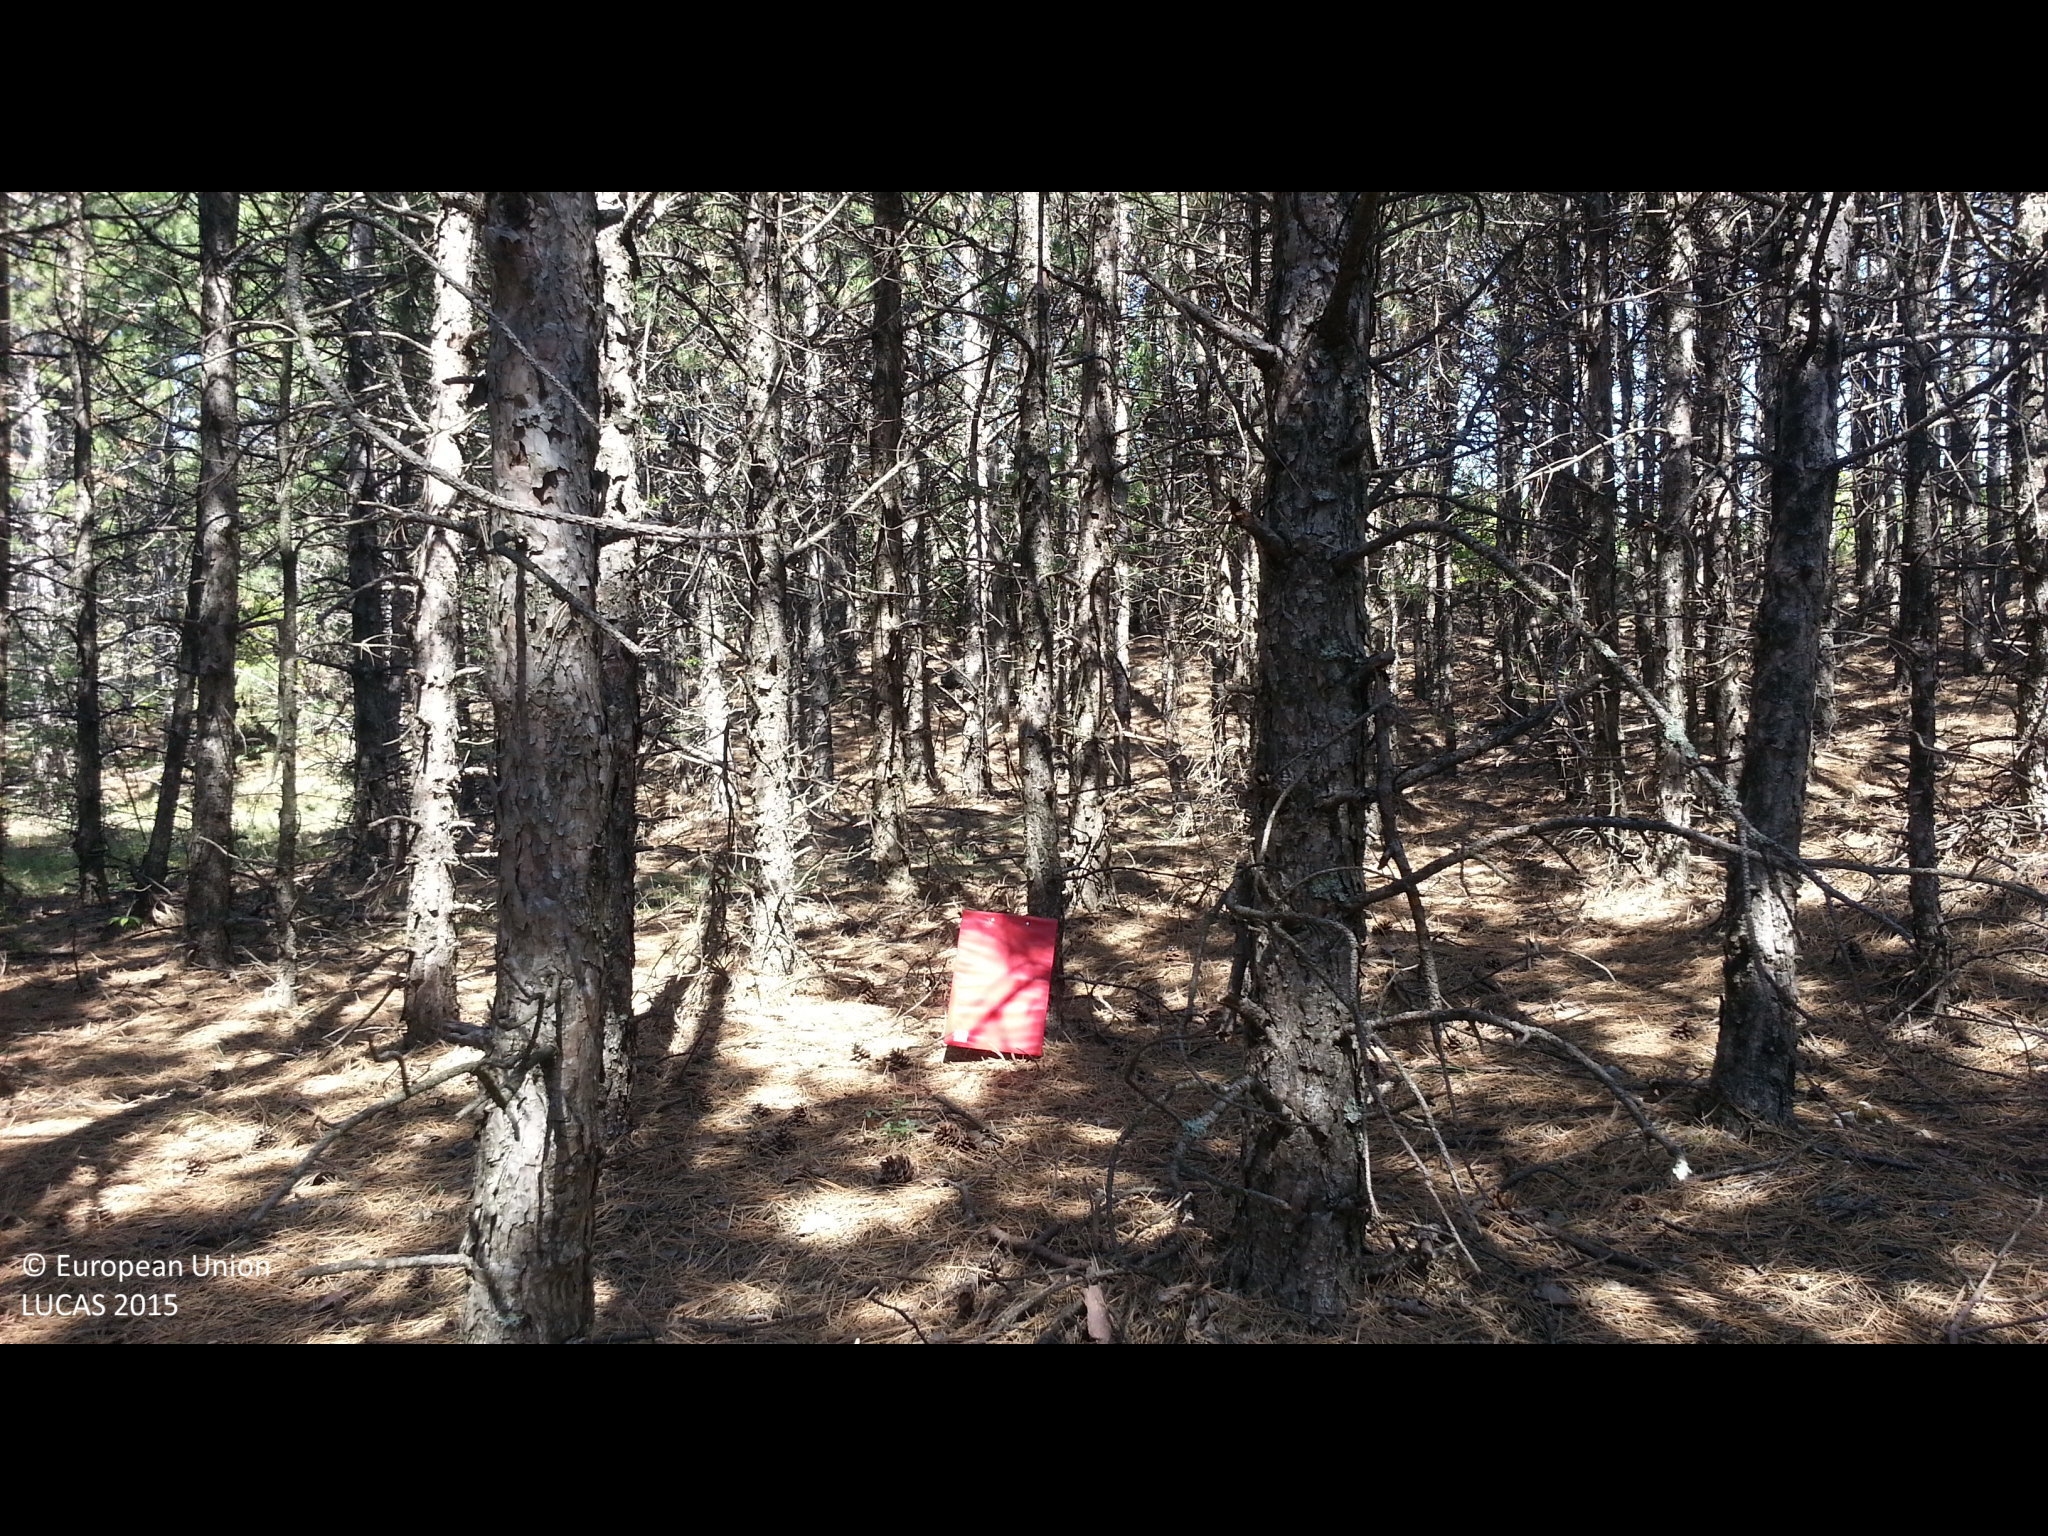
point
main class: Woodland
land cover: Pine dominated coniferous woodland
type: hemiboreal forest and nemoral coniferous forest and mixed broadleaved-coniferous forest
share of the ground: > 75 %
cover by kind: coniferous forest trees 100 %
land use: Forestry
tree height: > 5 m
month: August
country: BG
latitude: 42.5069
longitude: 23.1367
